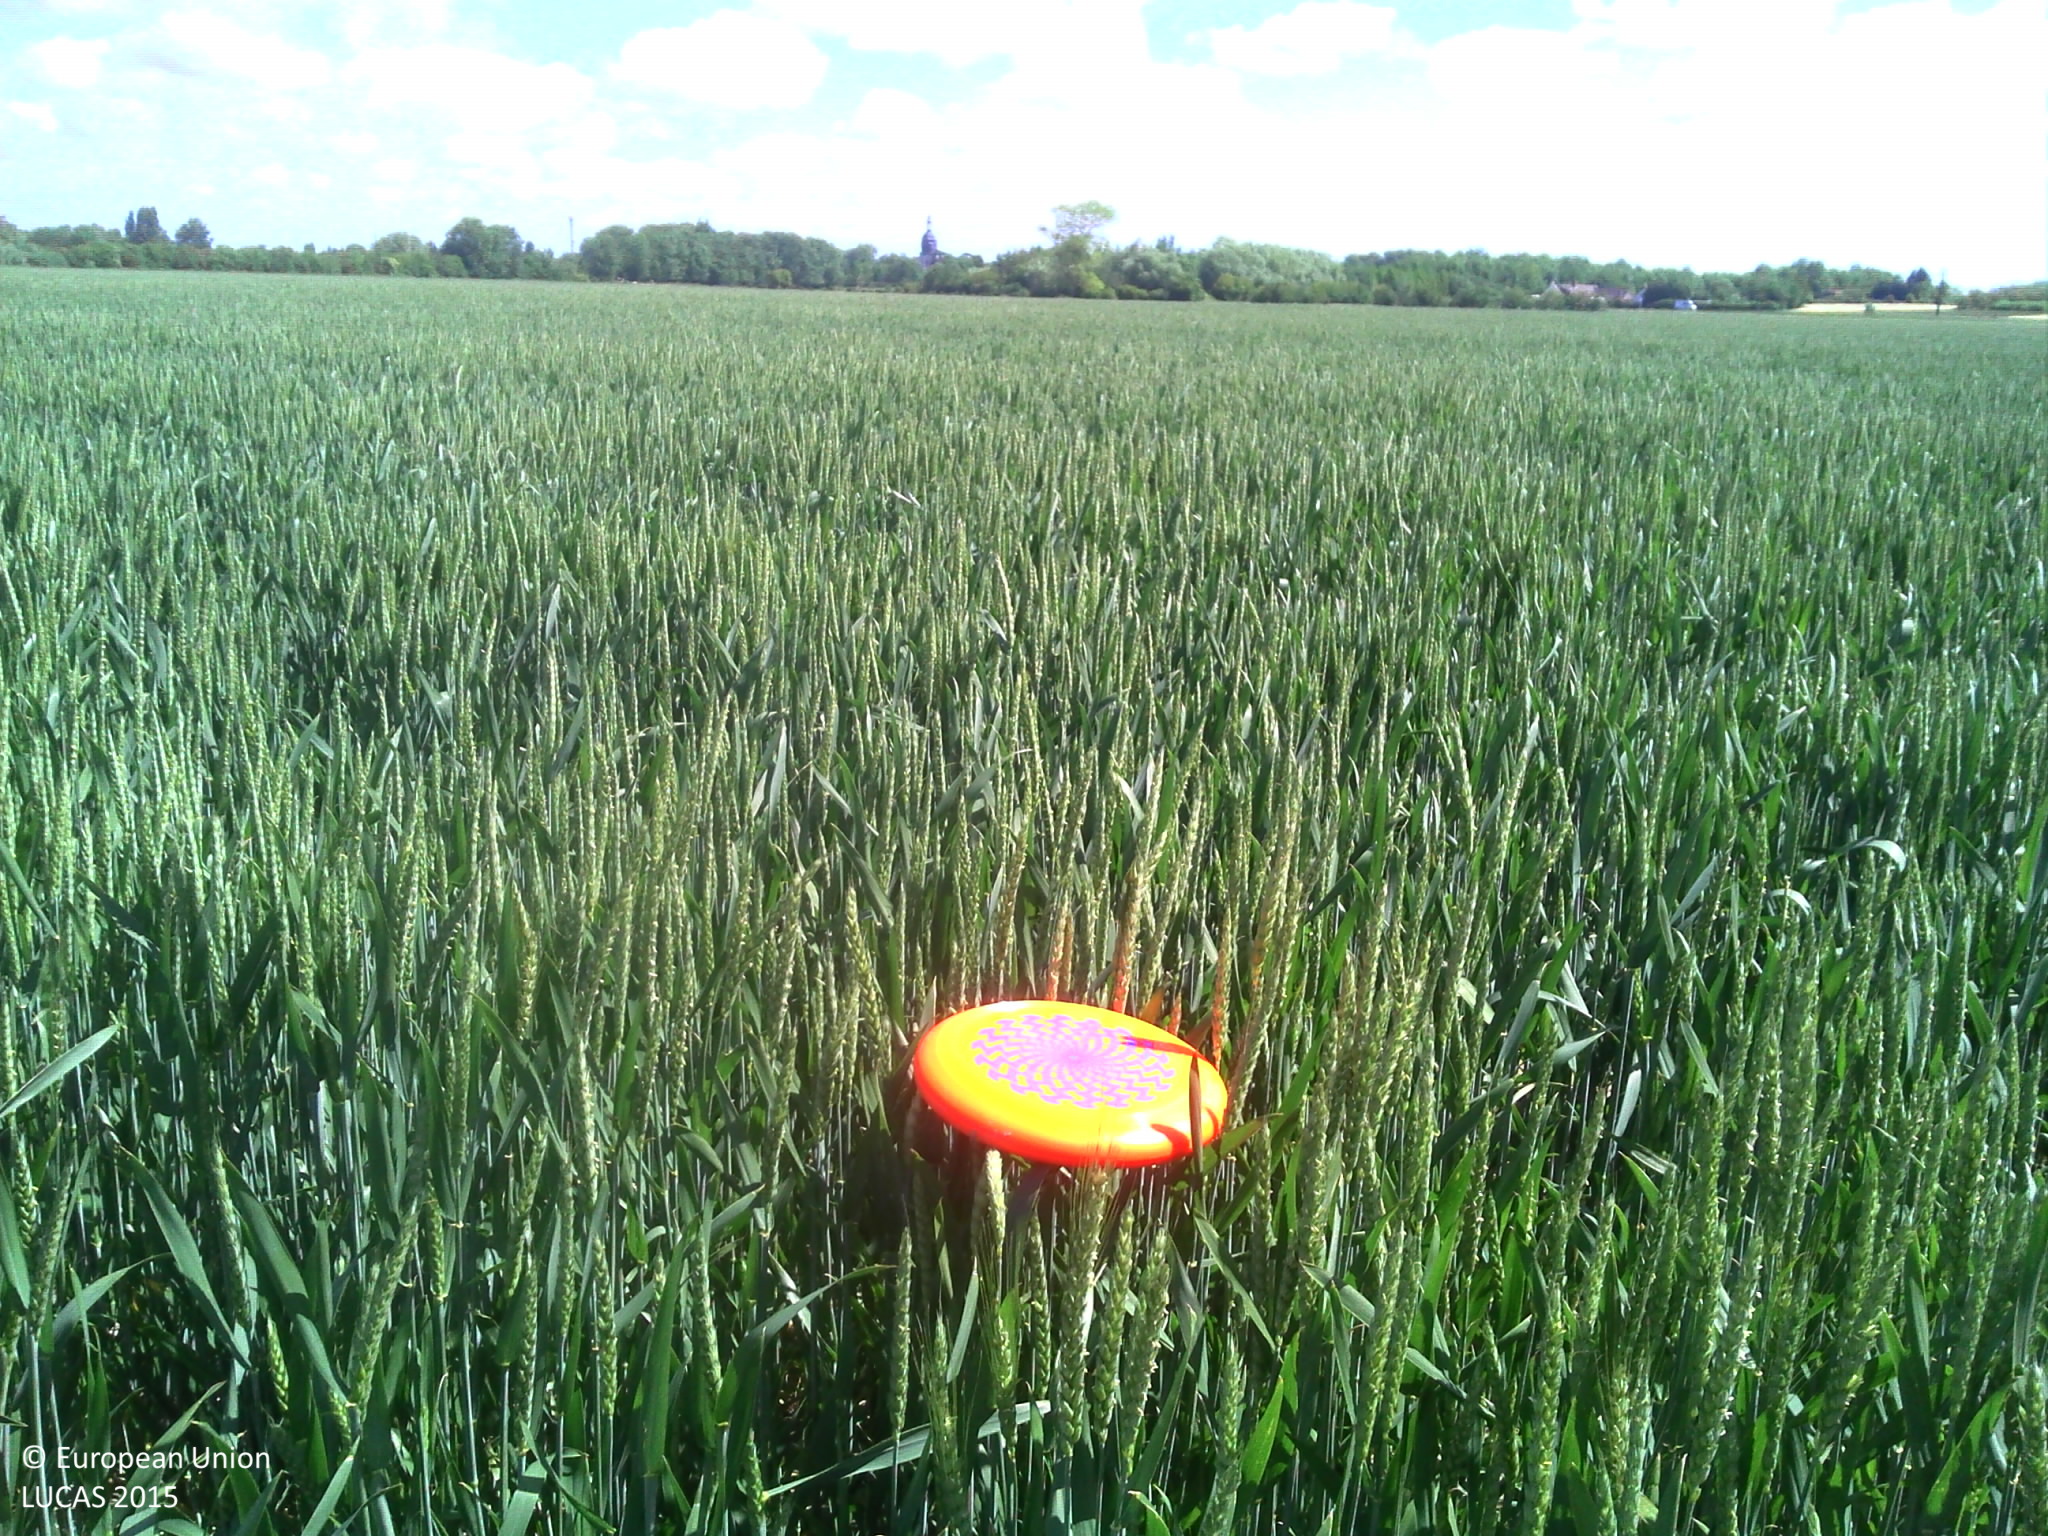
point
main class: Cropland
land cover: Common wheat
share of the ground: > 75 %
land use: Agriculture (excluding fallow land and kitchen gardens)
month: June
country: FR
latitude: 50.3098
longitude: 1.6269
